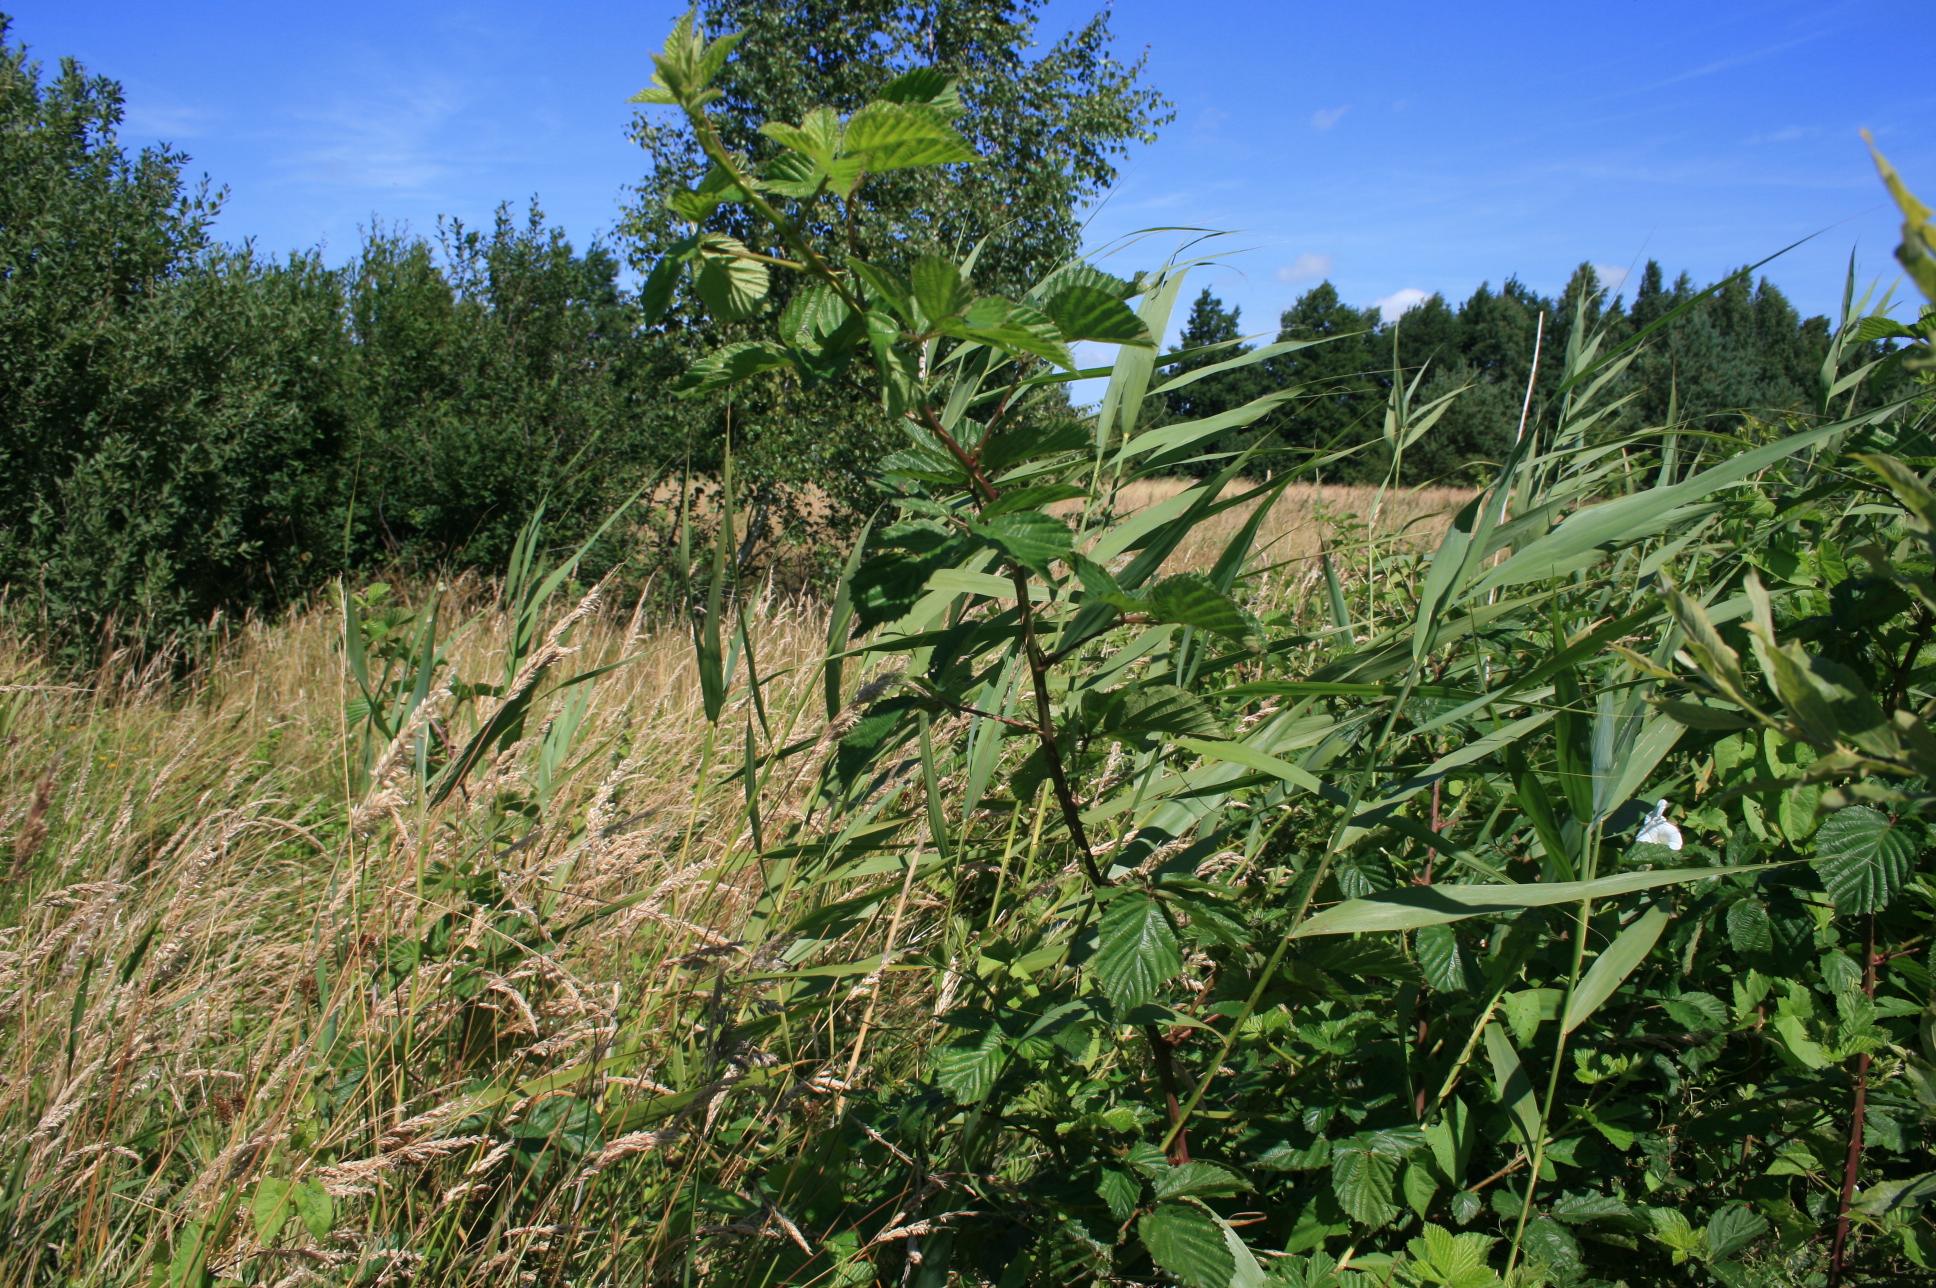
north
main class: Shrubland
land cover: Shrubland with sparse tree cover
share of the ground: 50 - 75 %
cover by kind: herbaceous plants 65 %, shrubs 30 %, broadleaved forest trees 5 %
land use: Semi-natural and natural areas not in use
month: July
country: LT
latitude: 55.4725
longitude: 21.2587
